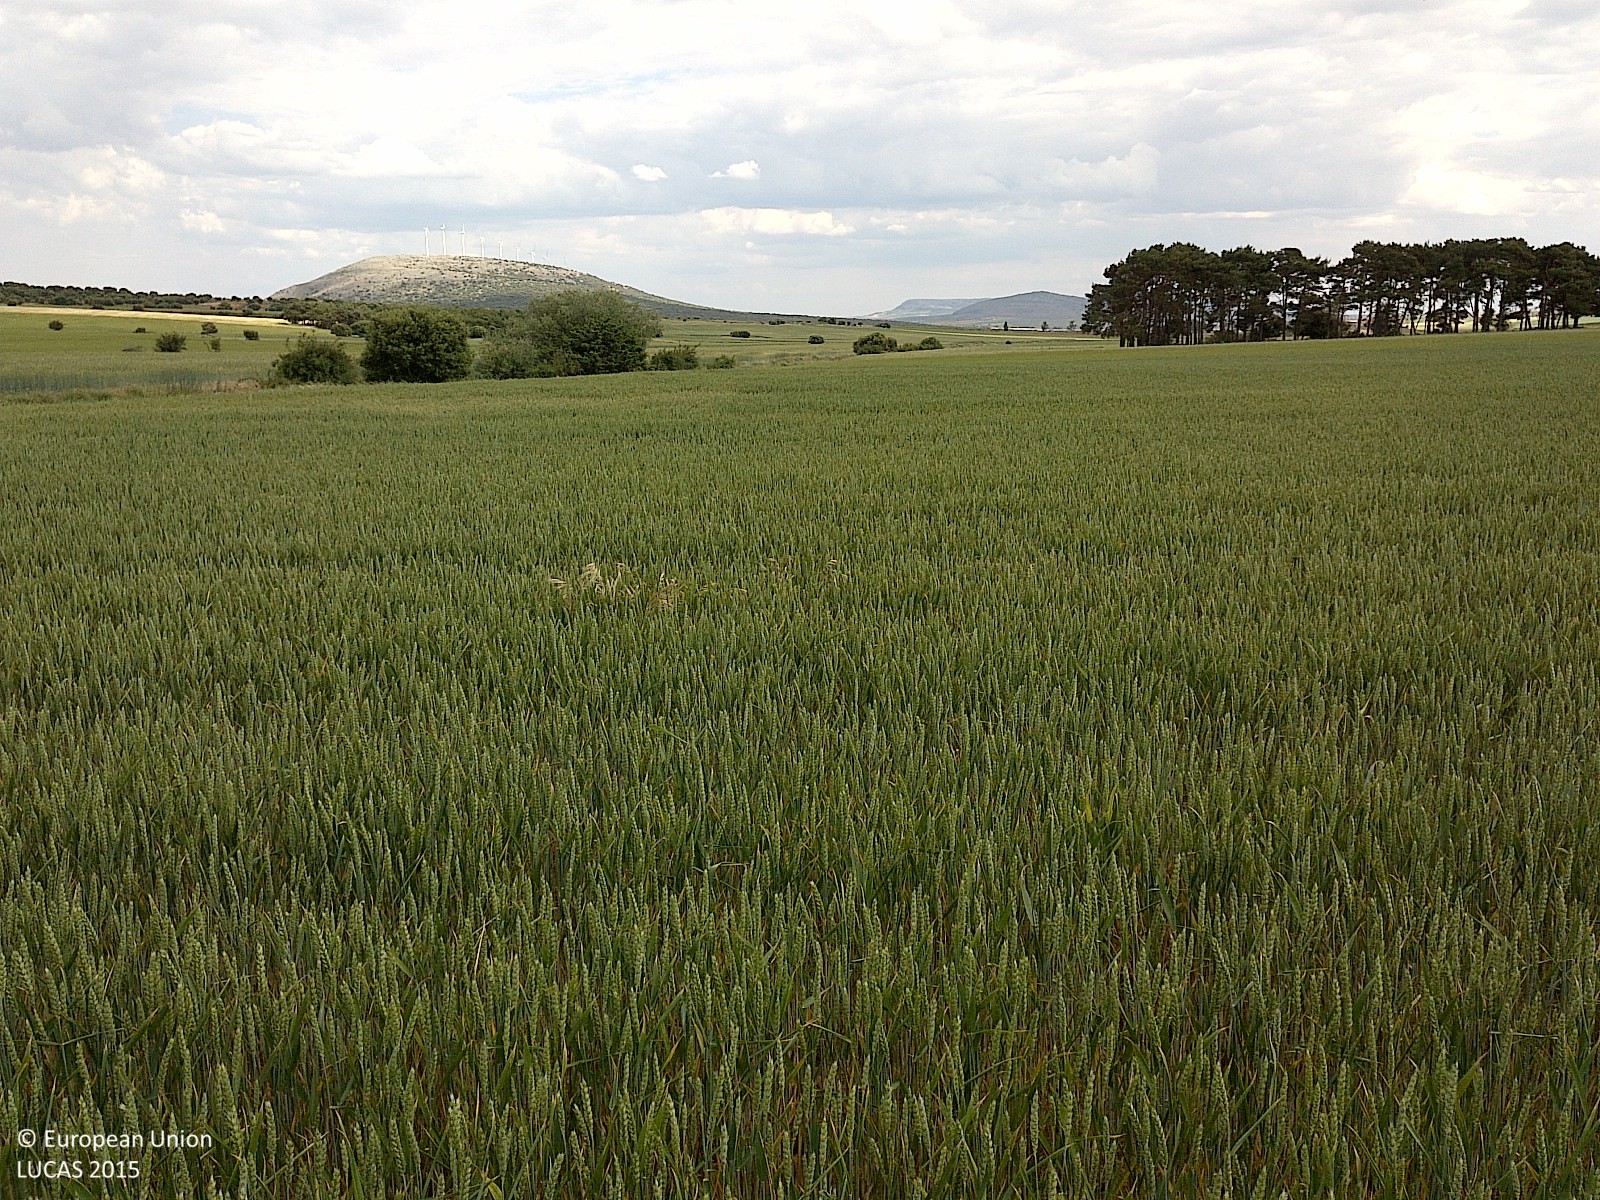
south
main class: Cropland
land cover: Common wheat
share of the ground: > 75 %
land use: Agriculture (excluding fallow land and kitchen gardens)
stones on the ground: < 10 %
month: June
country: ES
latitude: 41.7324
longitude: -2.1894
